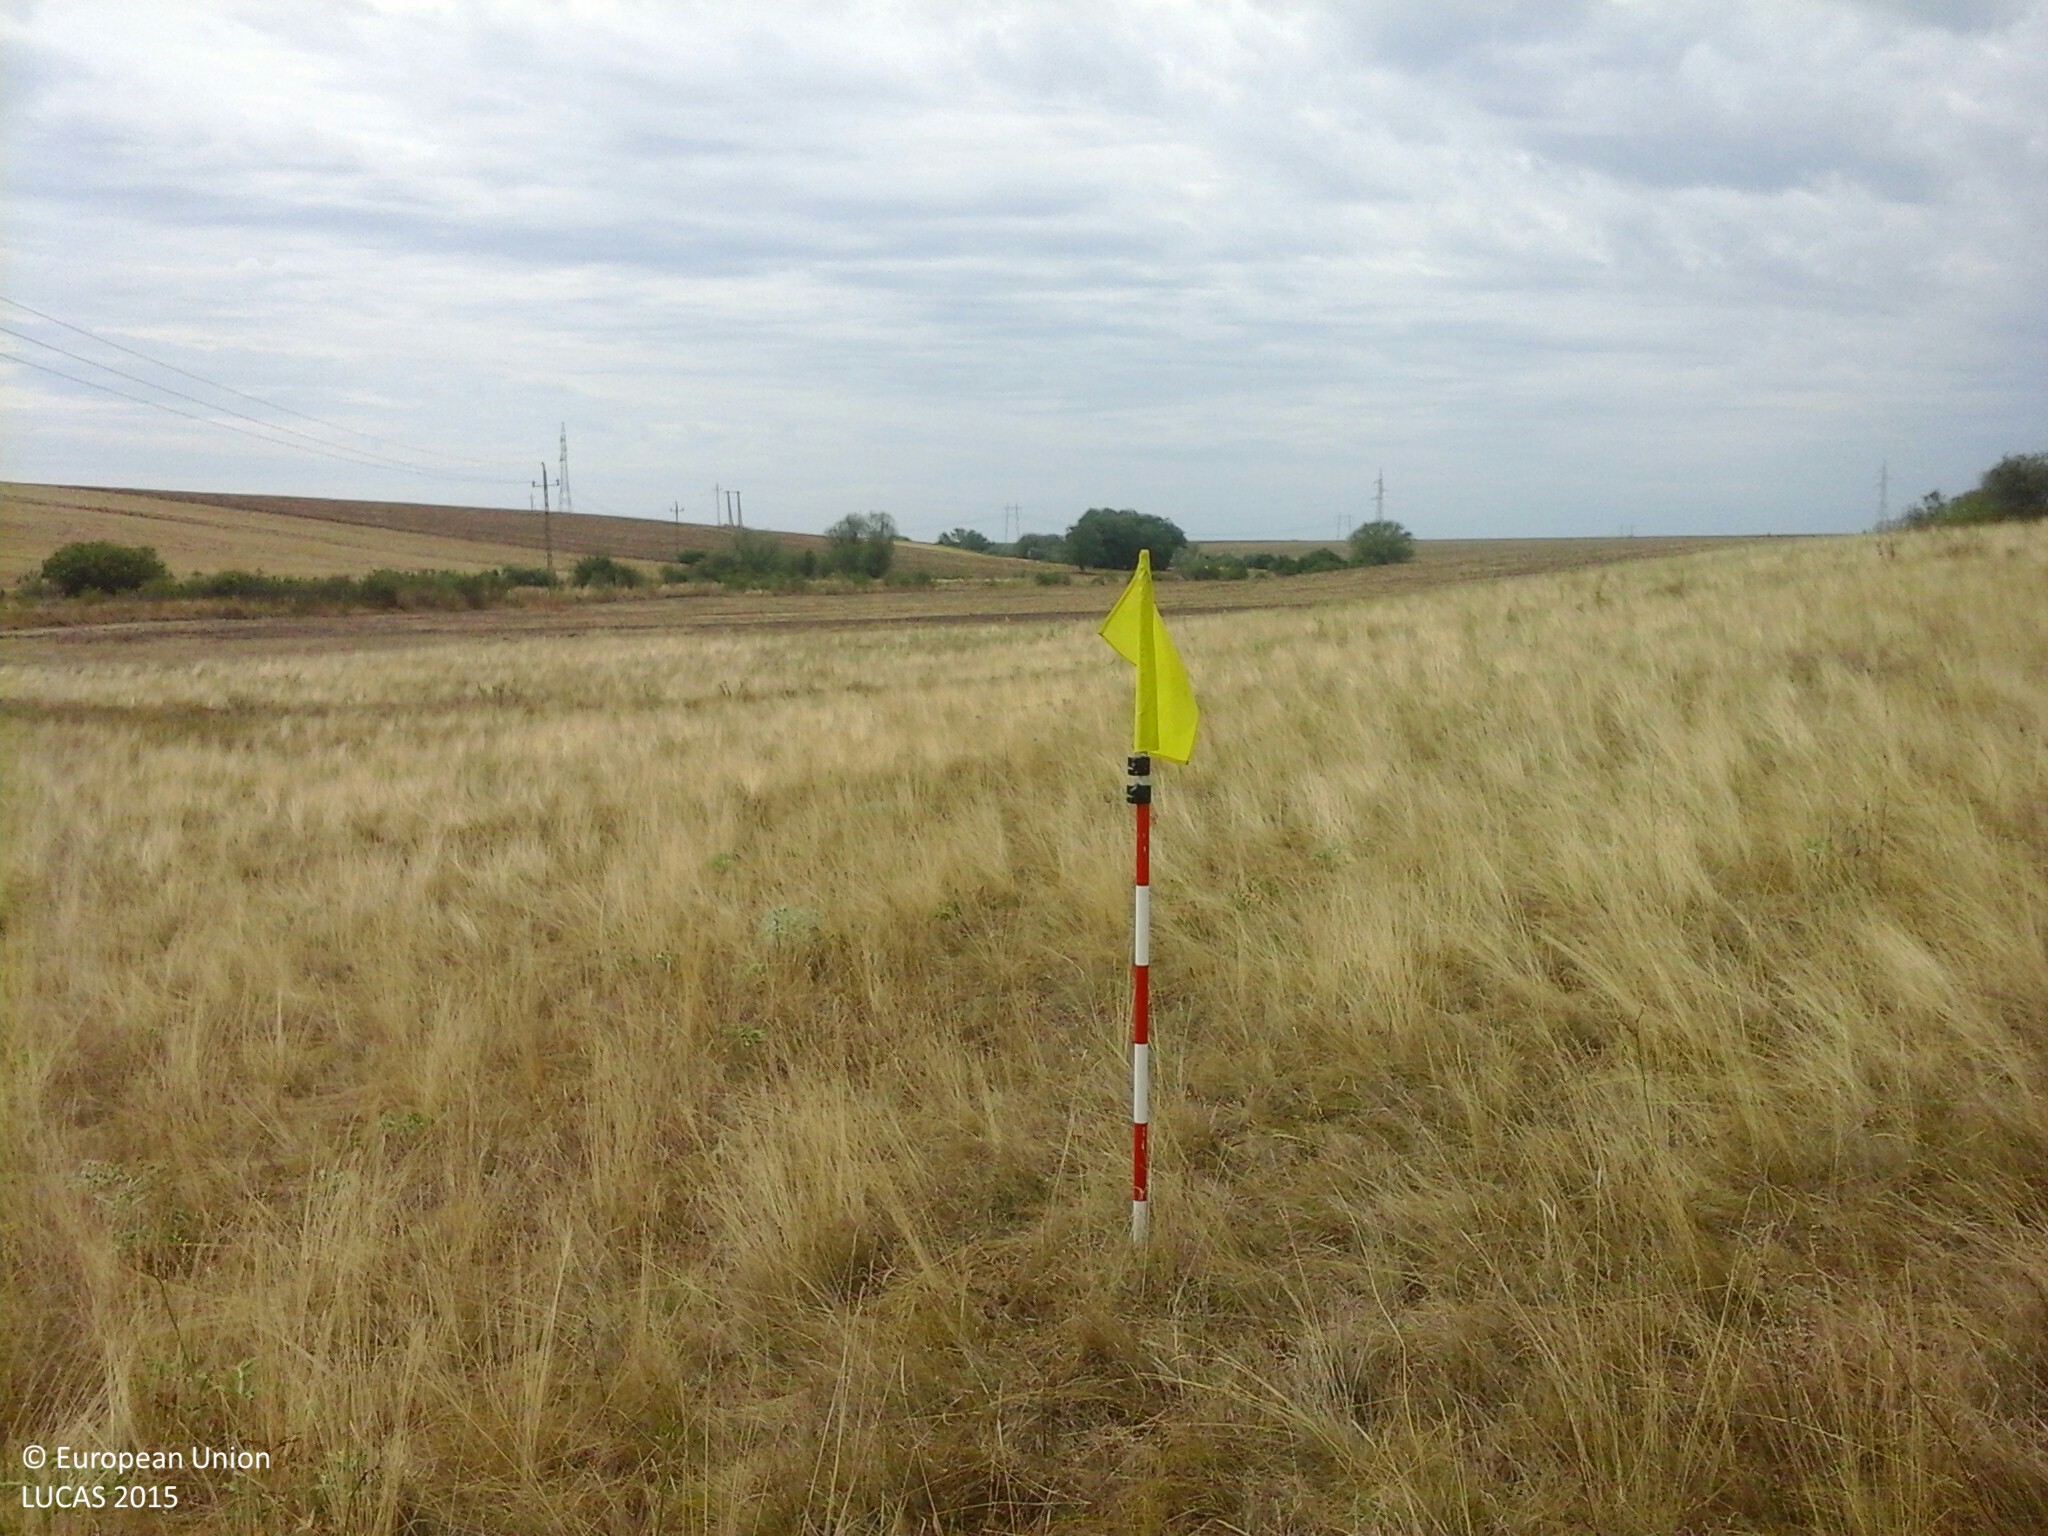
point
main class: Grassland
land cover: Grassland without tree/shrub cover
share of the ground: > 75 %
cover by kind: herbaceous plants 100 %
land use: Agriculture (excluding fallow land and kitchen gardens)
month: July
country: HU
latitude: 47.8708
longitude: 20.6360
